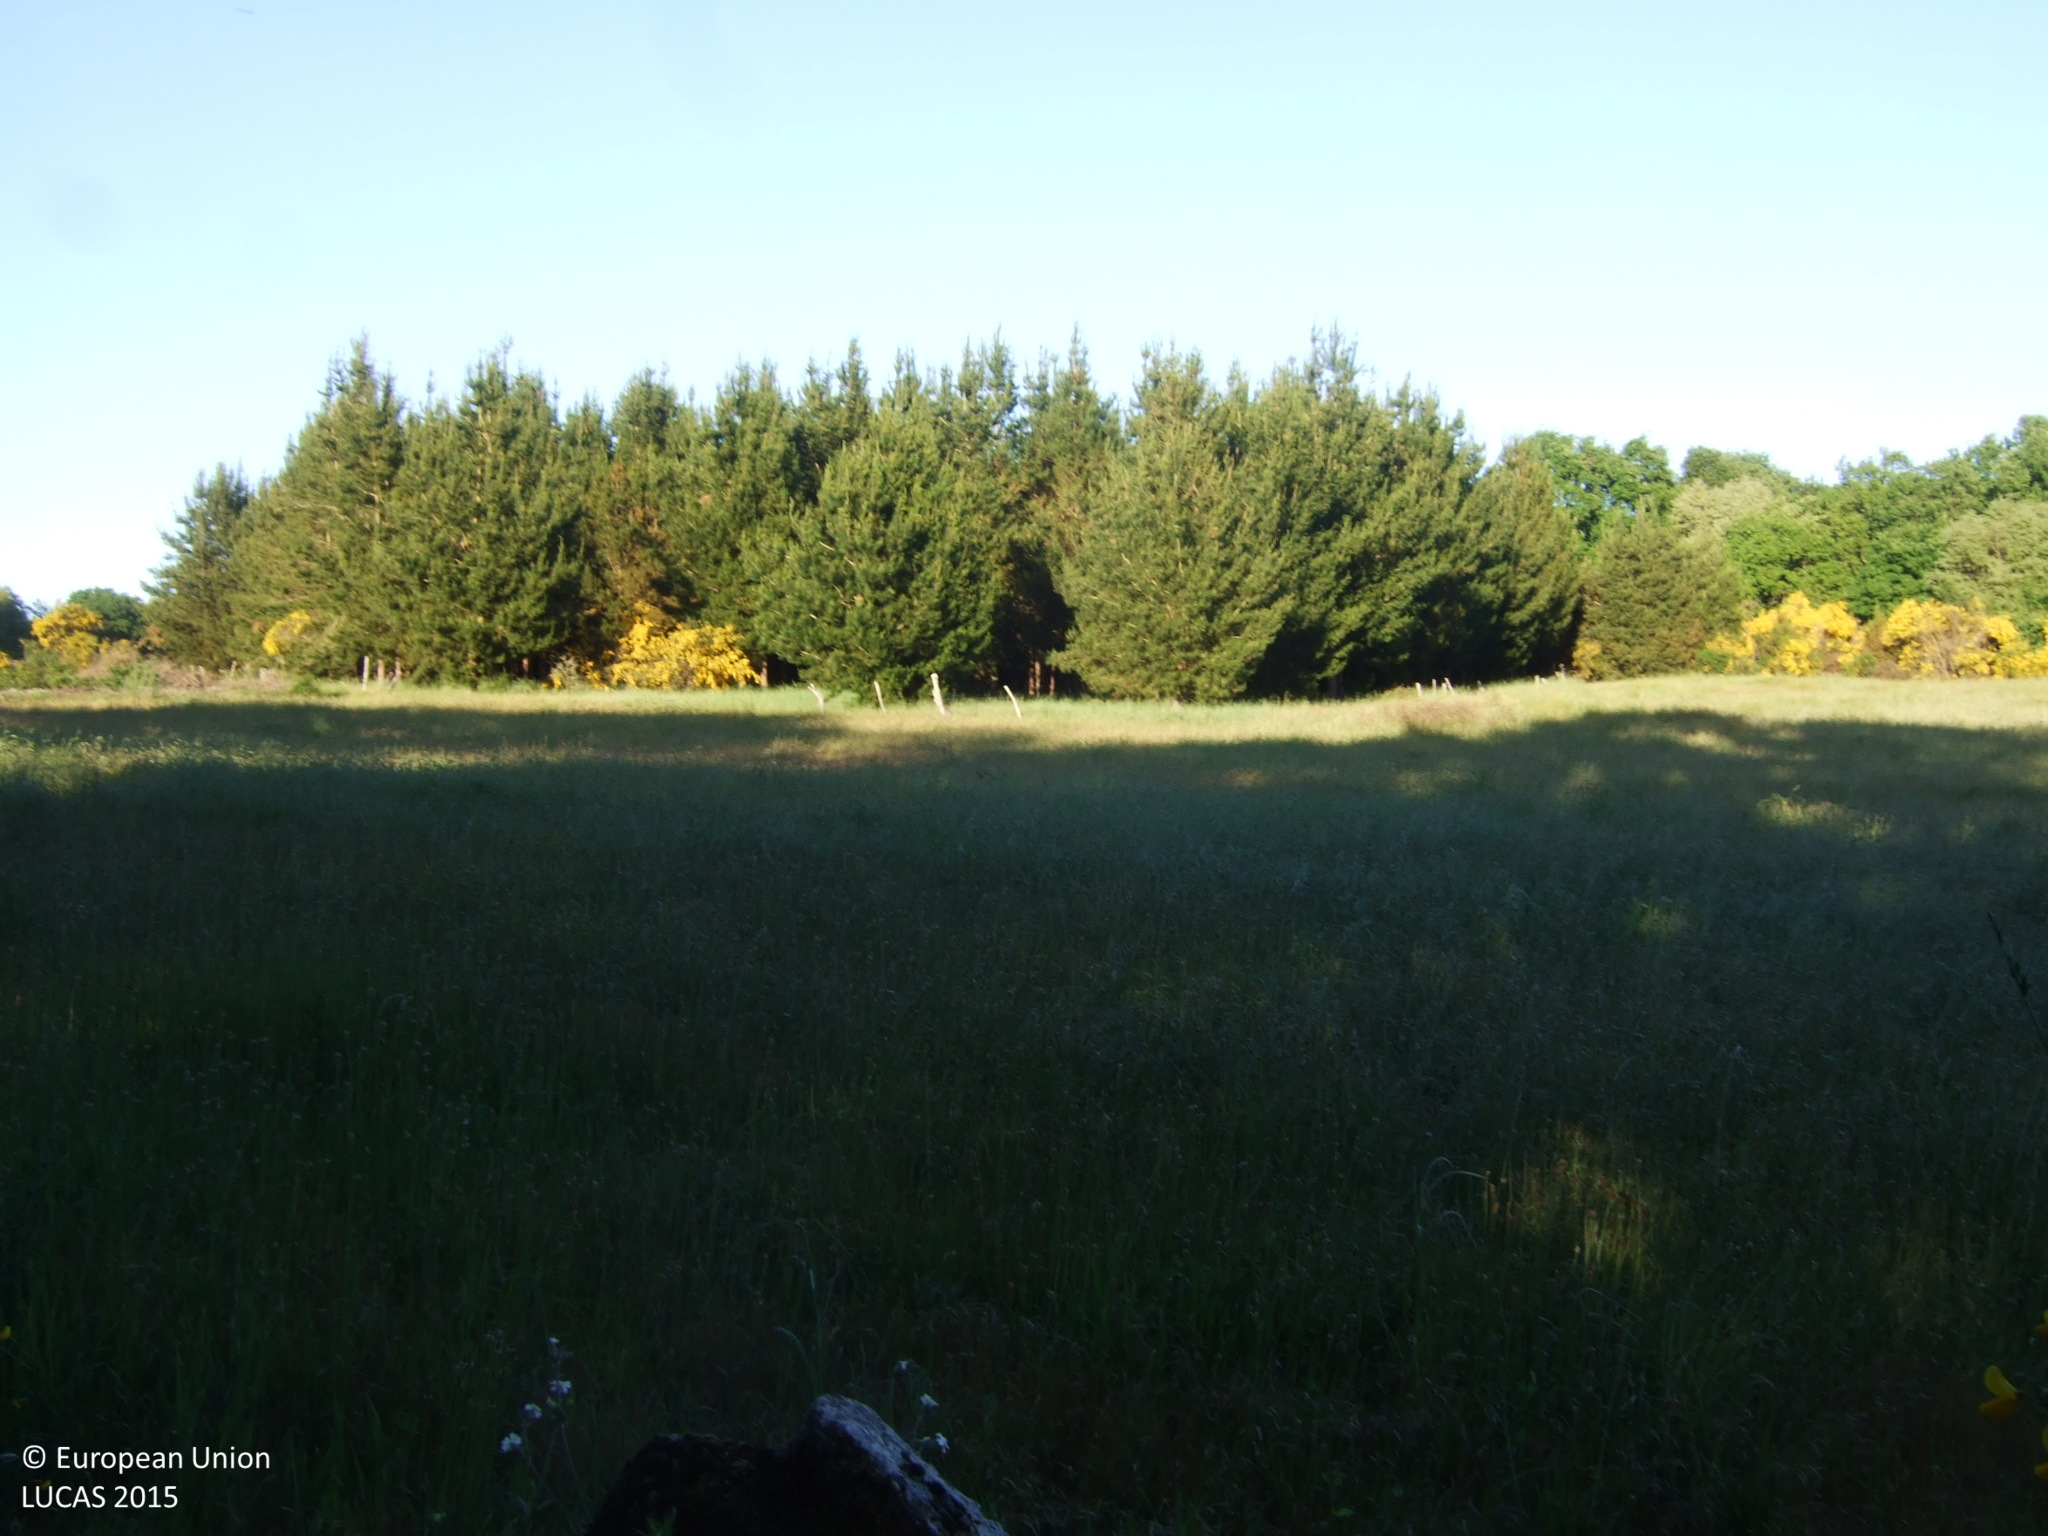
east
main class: Woodland
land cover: Broadleaved woodland
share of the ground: 25 - 50 %
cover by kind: broadleaved forest trees 50 %, herbaceous plants 30 %, shrubs 20 %
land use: Forestry
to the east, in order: Broadleaved woodland; Dry stone walls; Grassland without tree/shrub cover; Fences; Pine dominated coniferous woodland; Broadleaved woodland; Tracks; Dry stone walls; Groves; Grassland without tree/shrub cover
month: May
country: ES
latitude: 42.7556
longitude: -7.5083
